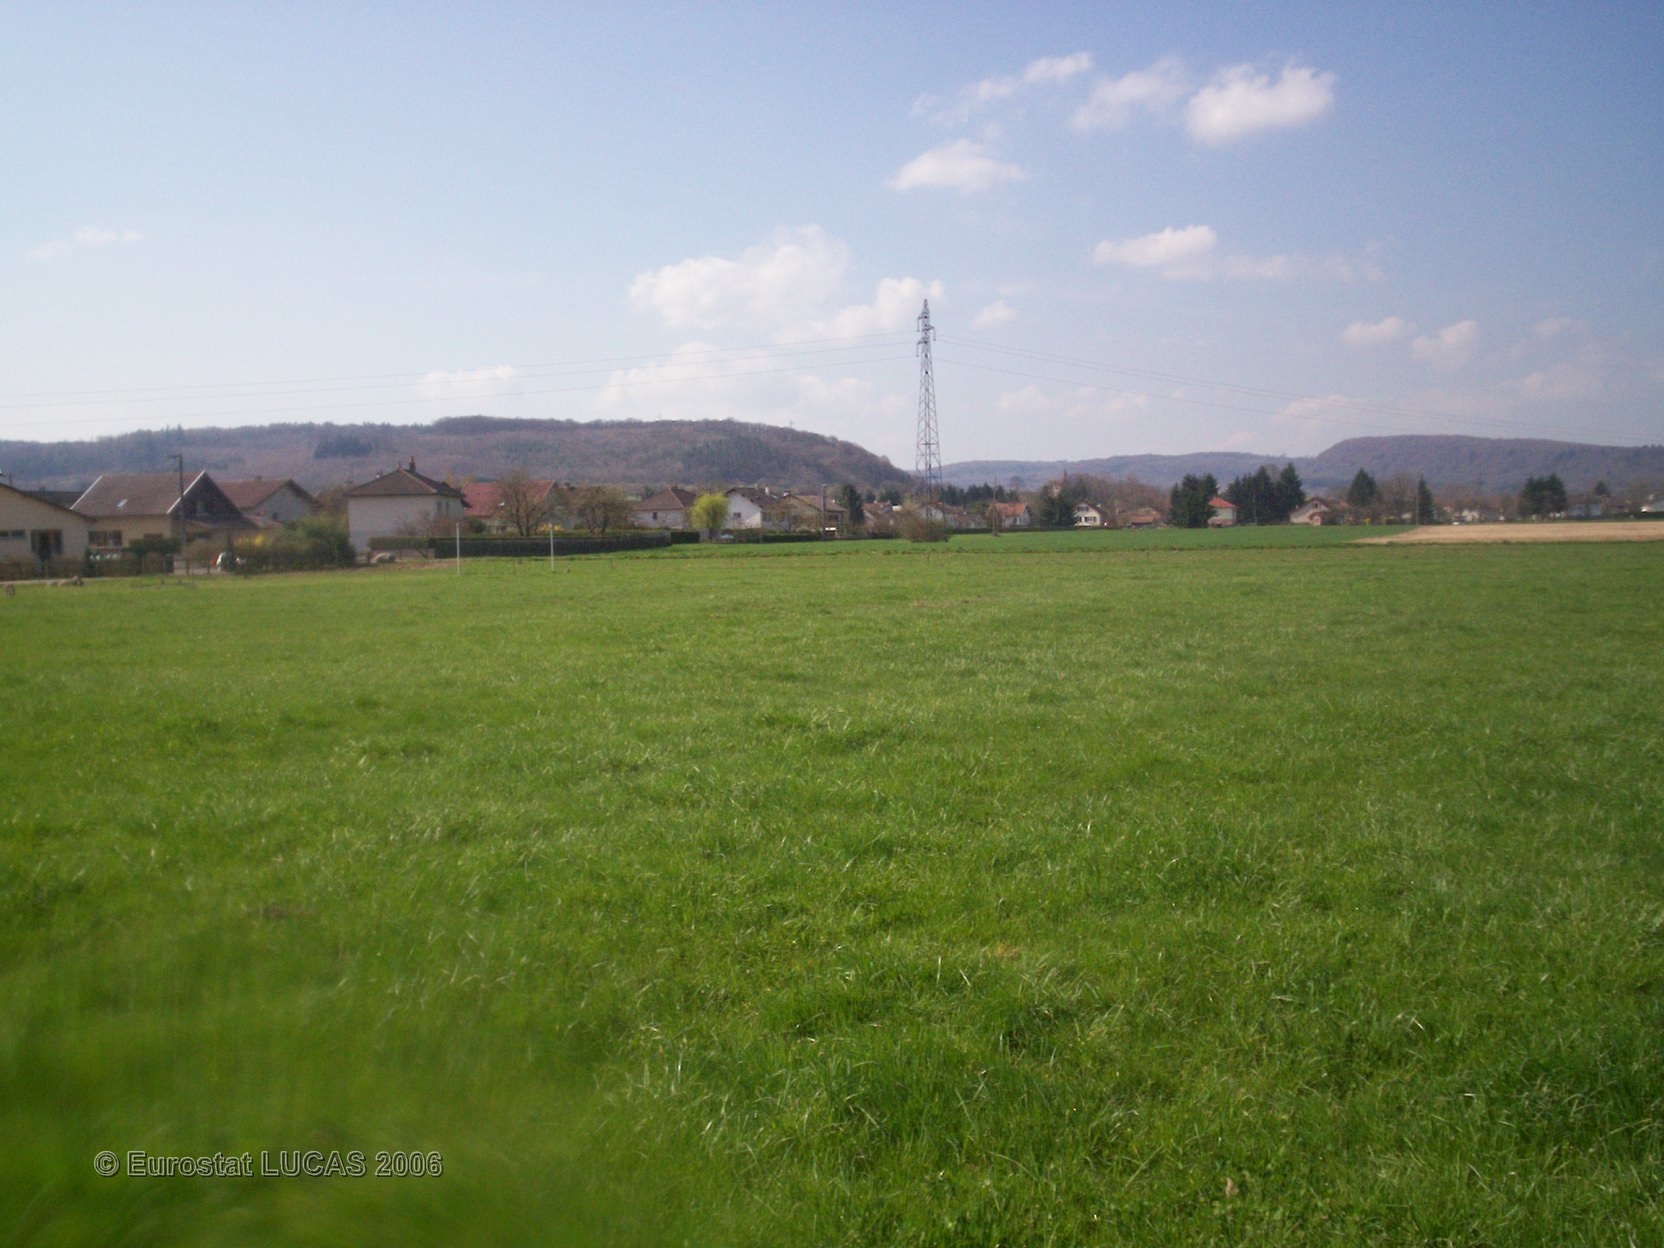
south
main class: Grassland
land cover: Grassland without tree/shrub cover
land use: Agriculture (excluding fallow land and kitchen gardens)
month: April
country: FR
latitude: 47.4568
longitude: 6.8050
